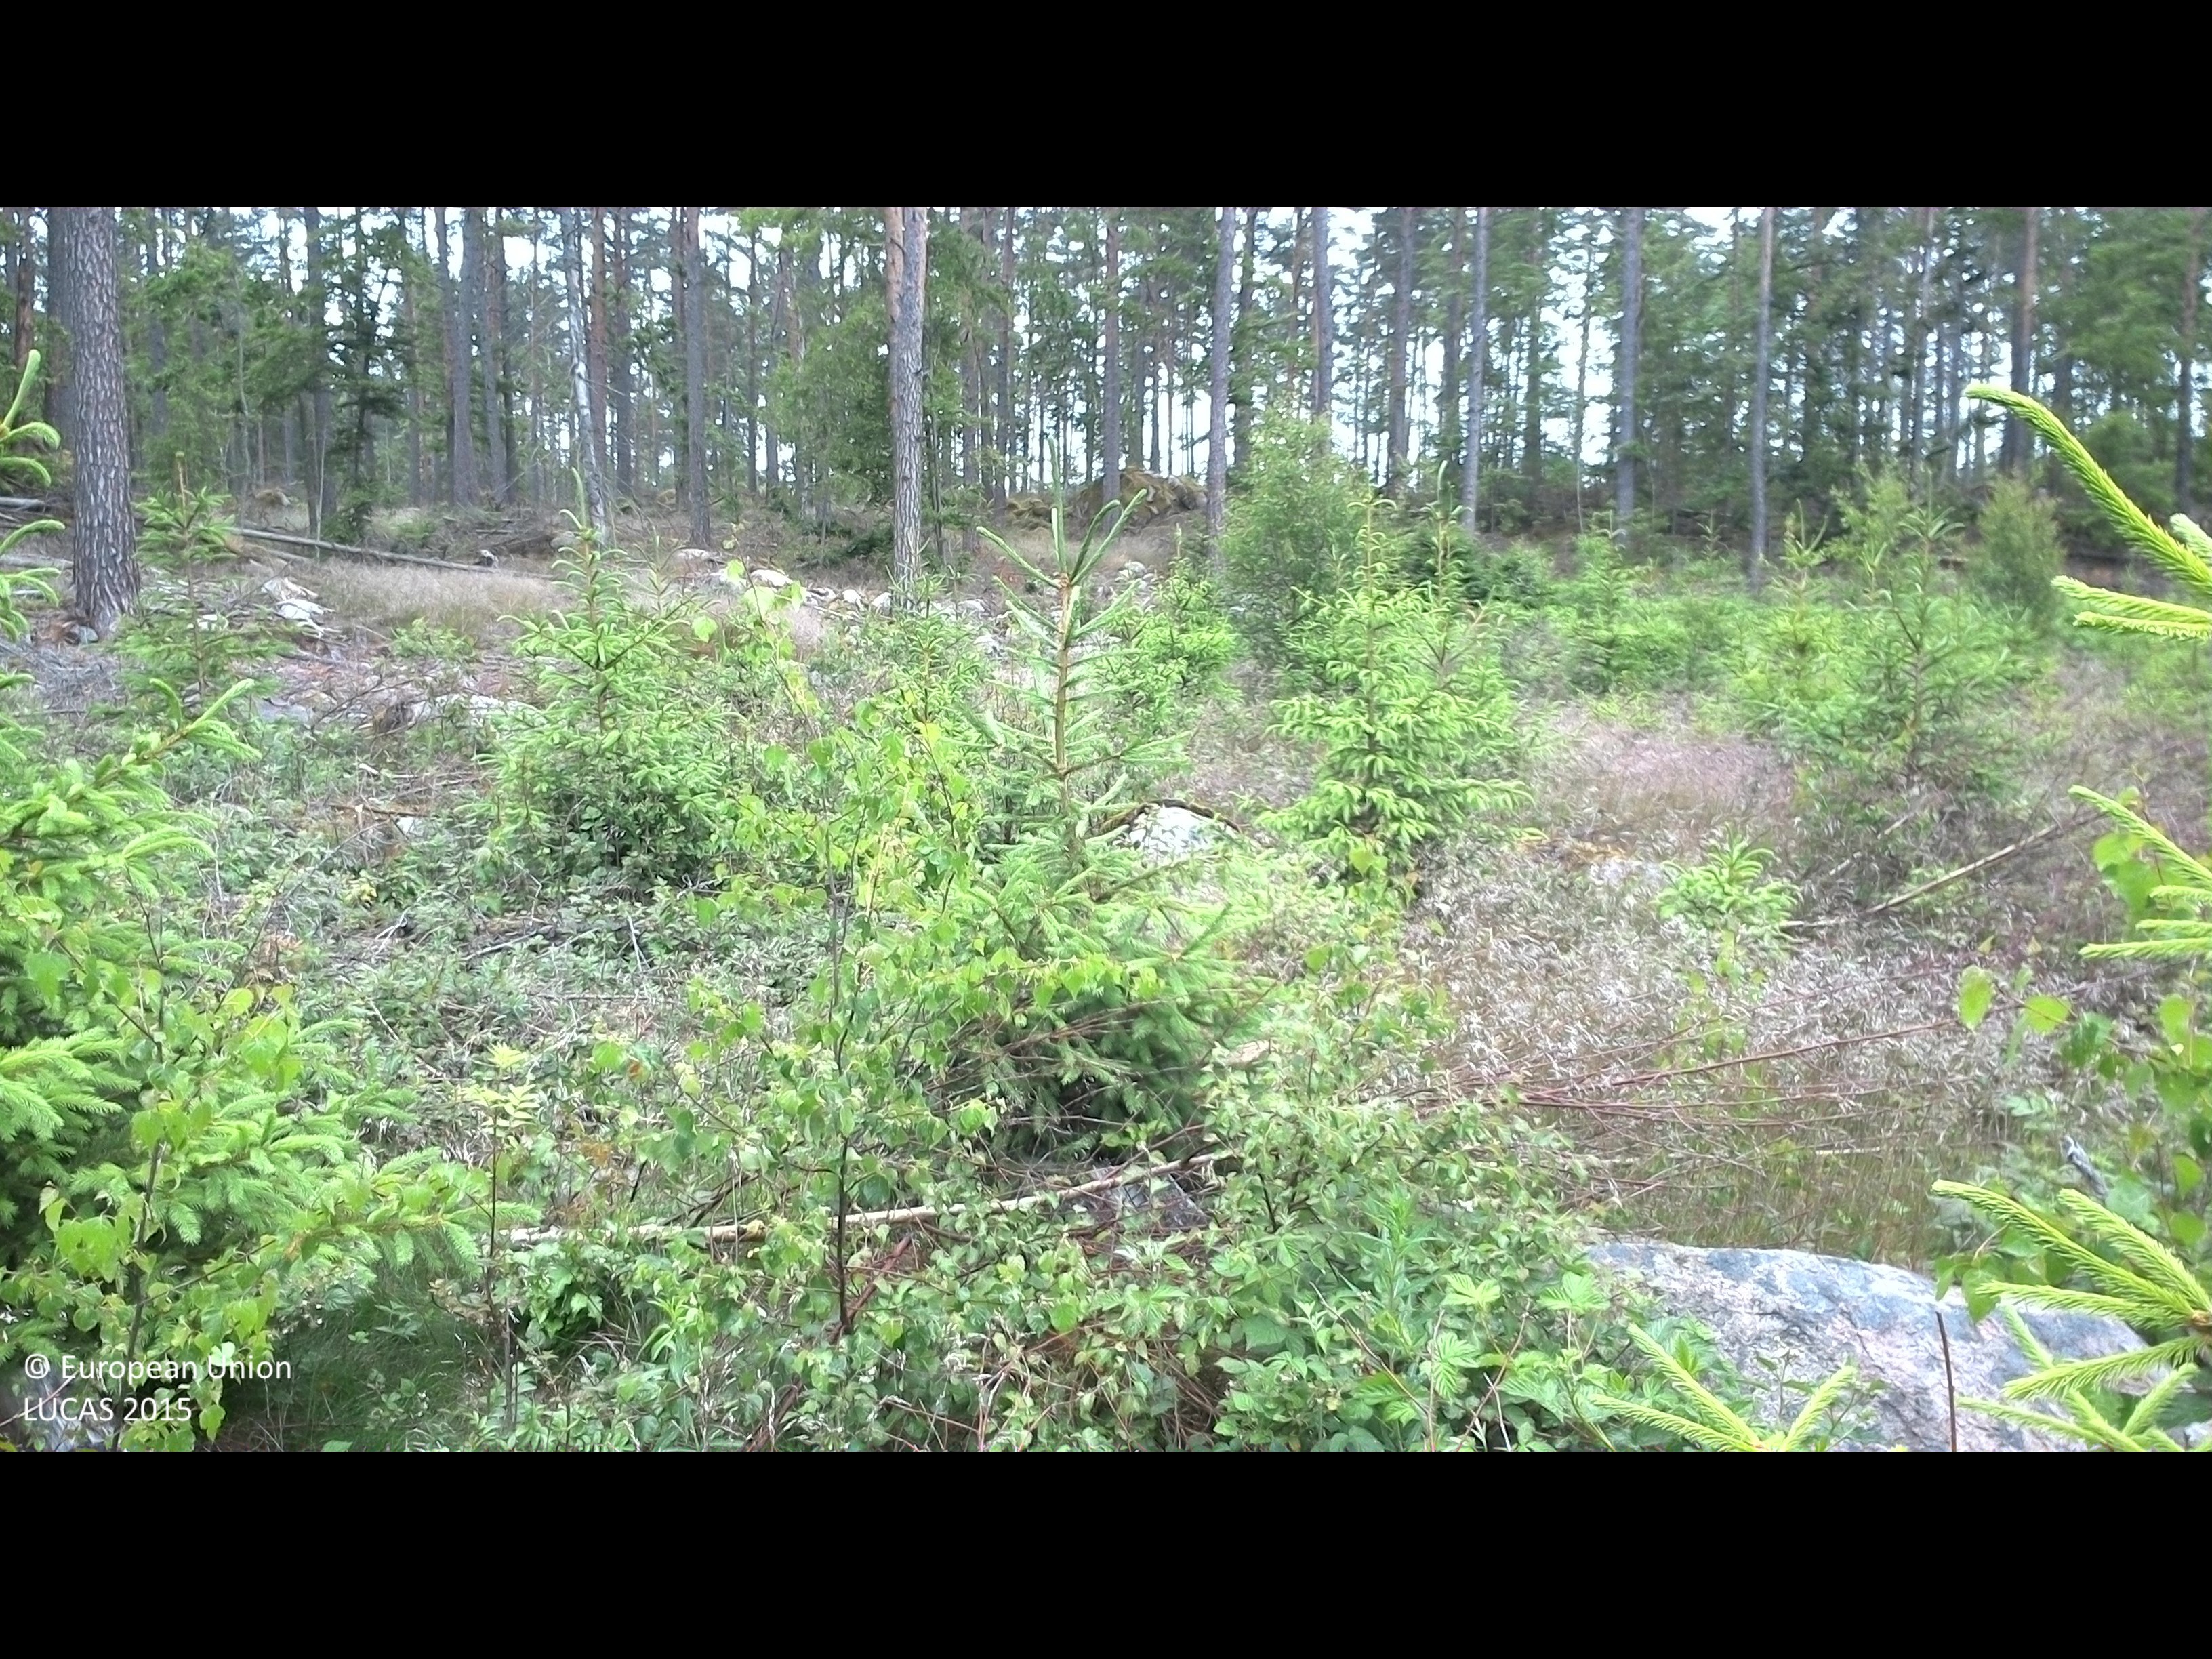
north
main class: Woodland
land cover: Spruce dominated mixed woodland
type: boreal forest
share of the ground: 25 - 50 %
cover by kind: coniferous forest trees 35 %, shrubs 30 %, herbaceous plants 20 %, broadleaved forest trees 15 %
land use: Forestry
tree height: < 5 m
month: June
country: SE
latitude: 56.4478
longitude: 15.9215
